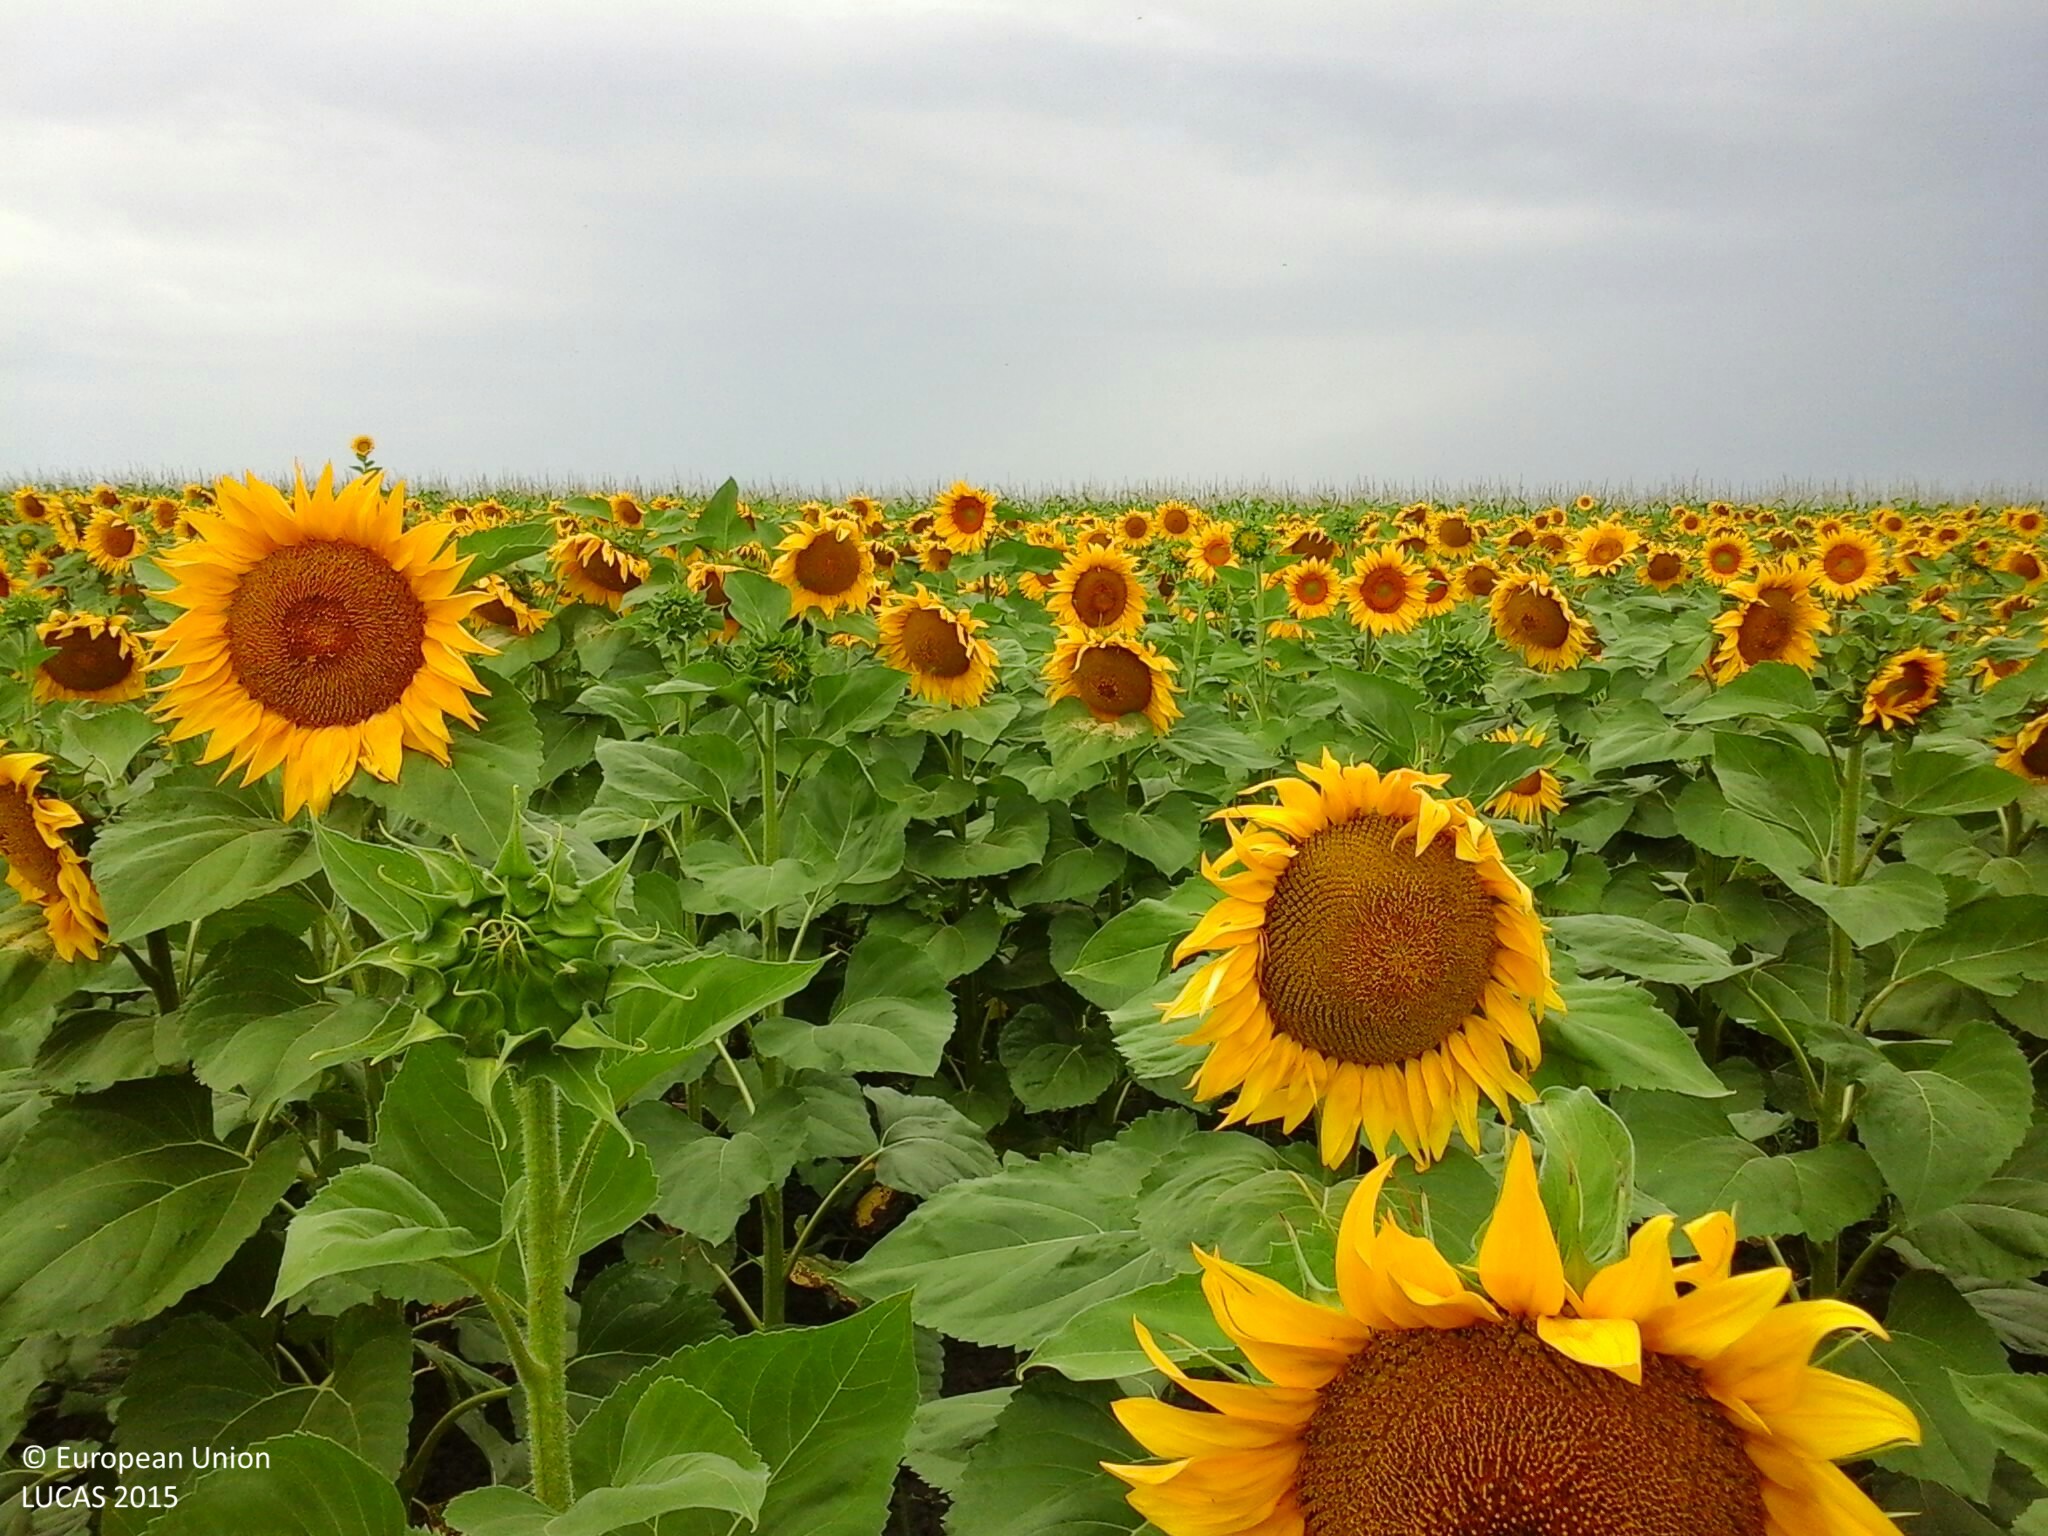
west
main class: Cropland
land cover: Sunflower
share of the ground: 50 - 75 %
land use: Agriculture (excluding fallow land and kitchen gardens)
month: July
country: HU
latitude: 46.9404
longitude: 20.3126
